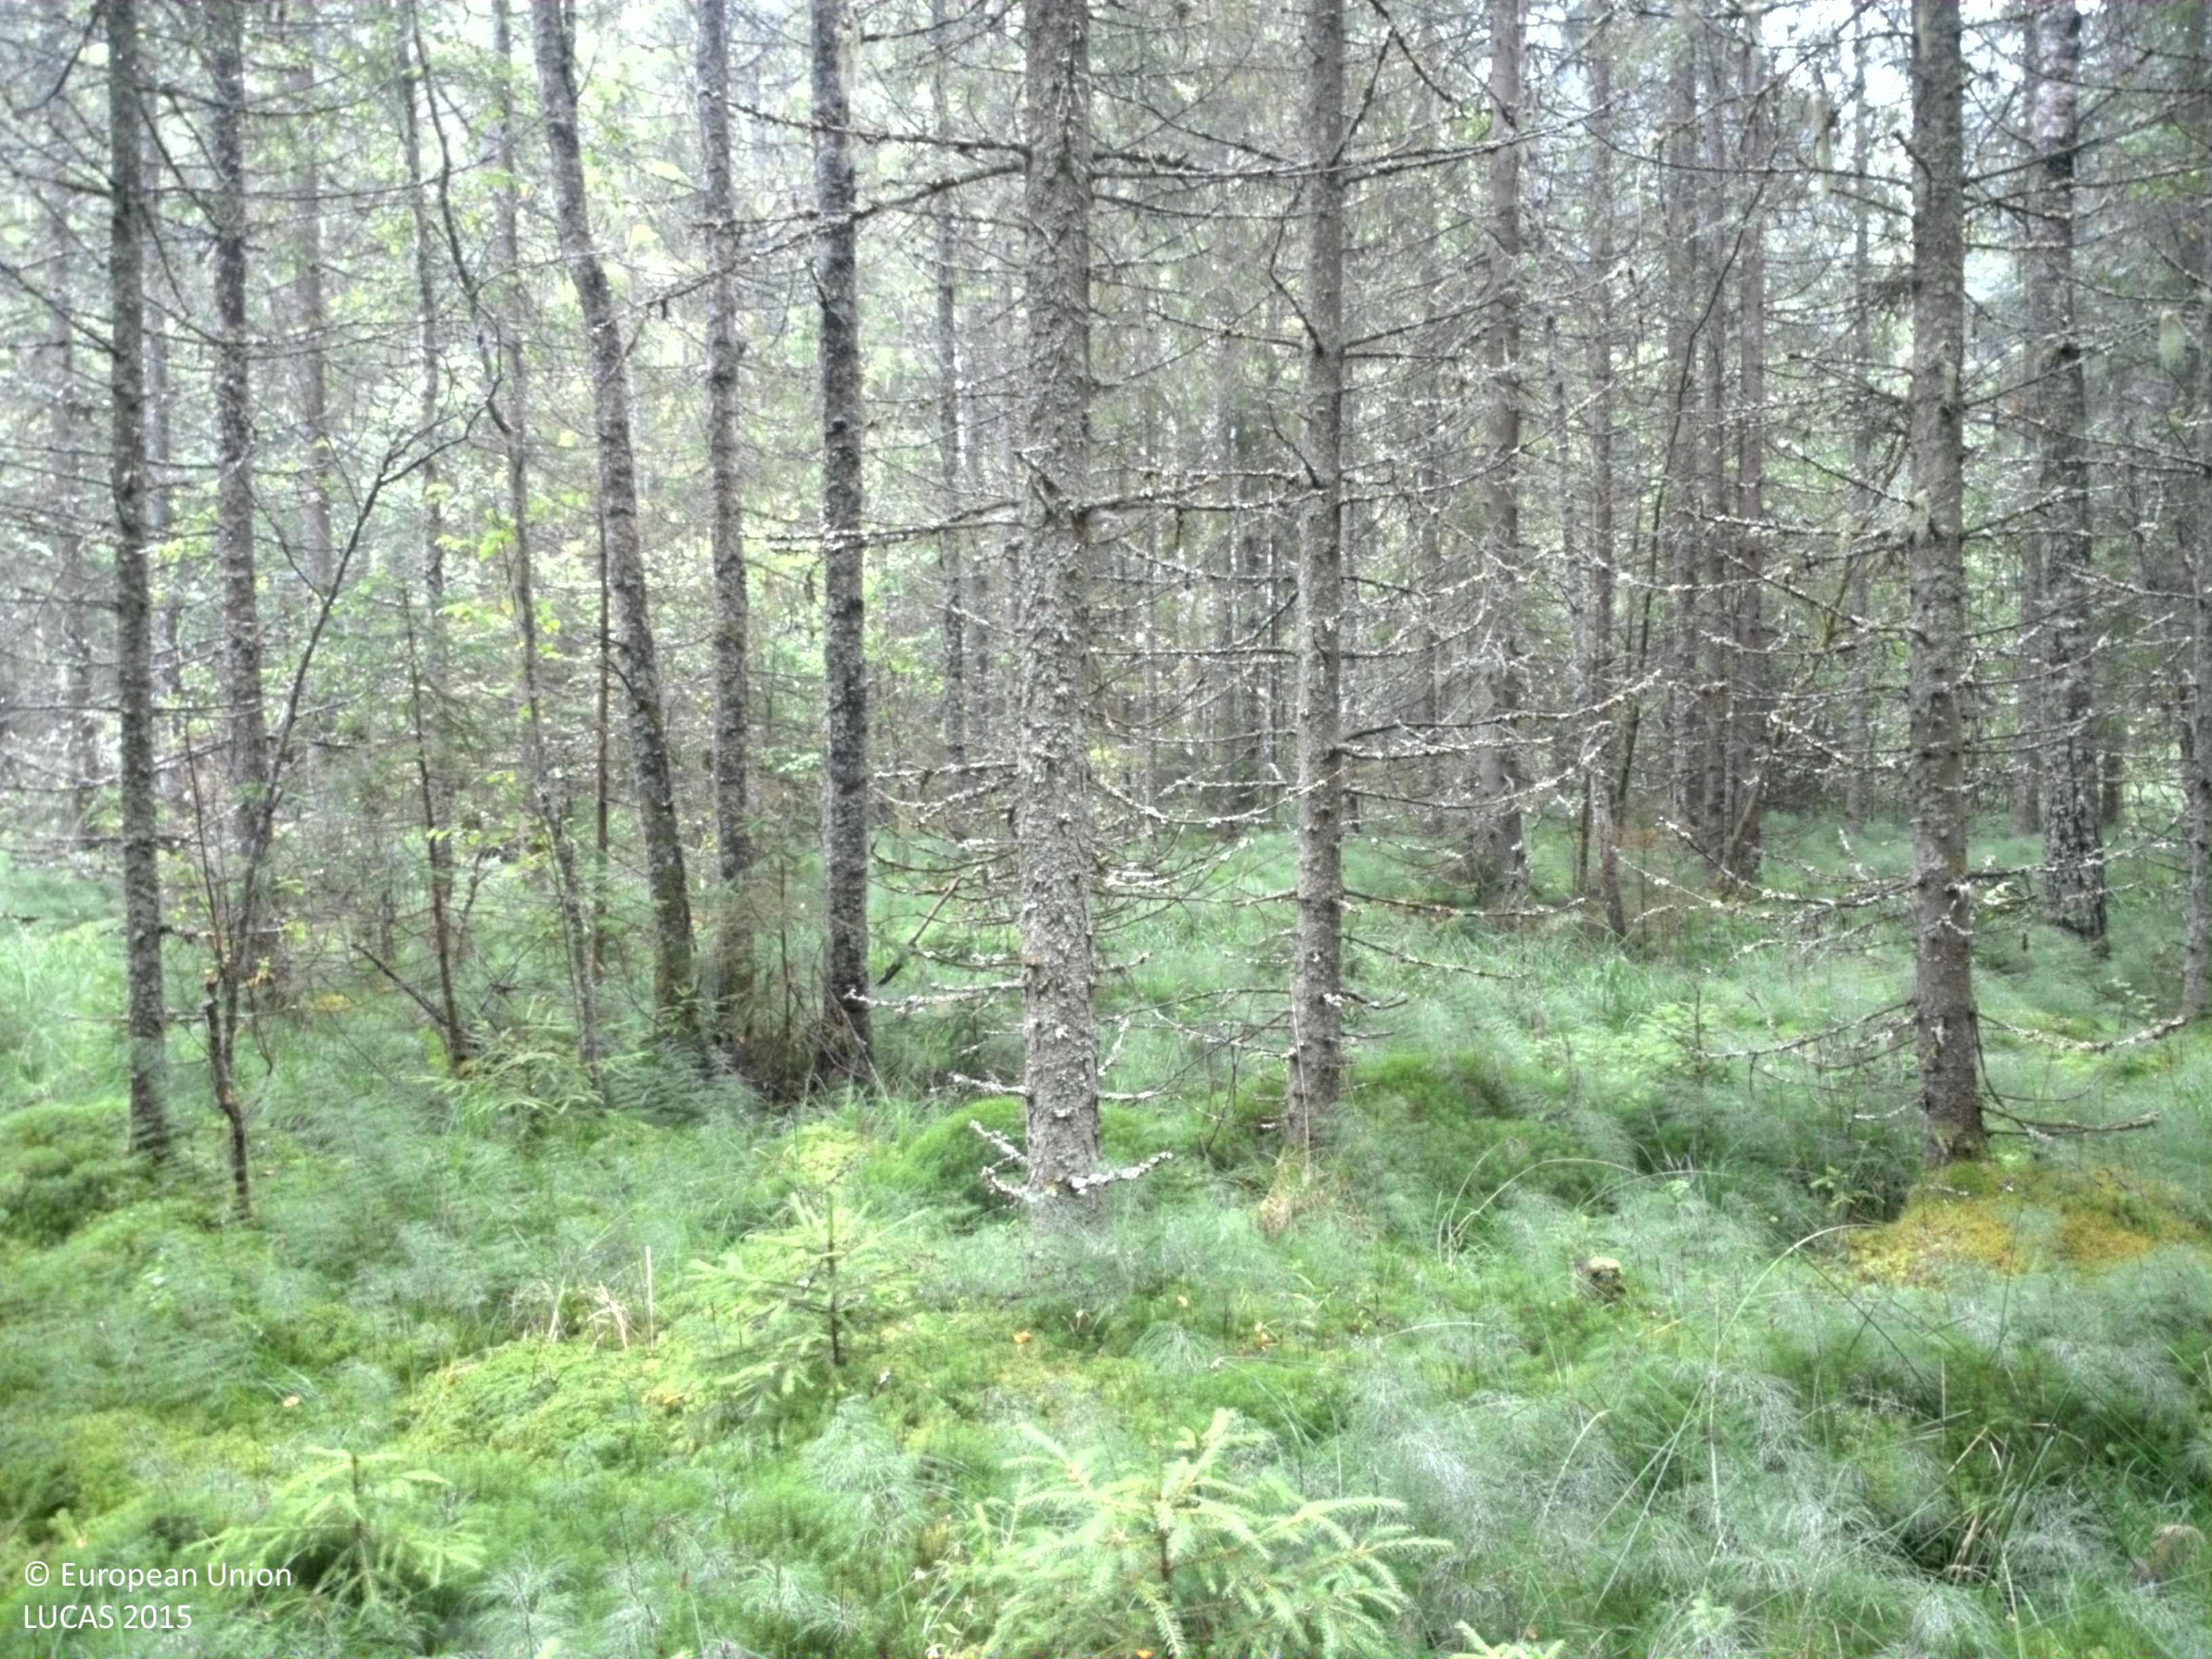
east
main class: Woodland
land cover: Spruce dominated coniferous woodland
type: boreal forest
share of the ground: 50 - 75 %
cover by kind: coniferous forest trees 65 %, shrubs 20 %, lichens and mosses 10 %, broadleaved forest trees 5 %
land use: Forestry
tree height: > 5 m
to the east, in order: Spruce dominated coniferous woodland; Rivers and streams; Spruce dominated mixed woodland; Spruce dominated coniferous woodland; Tracks; Spruce dominated mixed woodland; Tracks; Spruce dominated mixed woodland
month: August
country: SE
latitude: 59.4602
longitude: 13.1859
